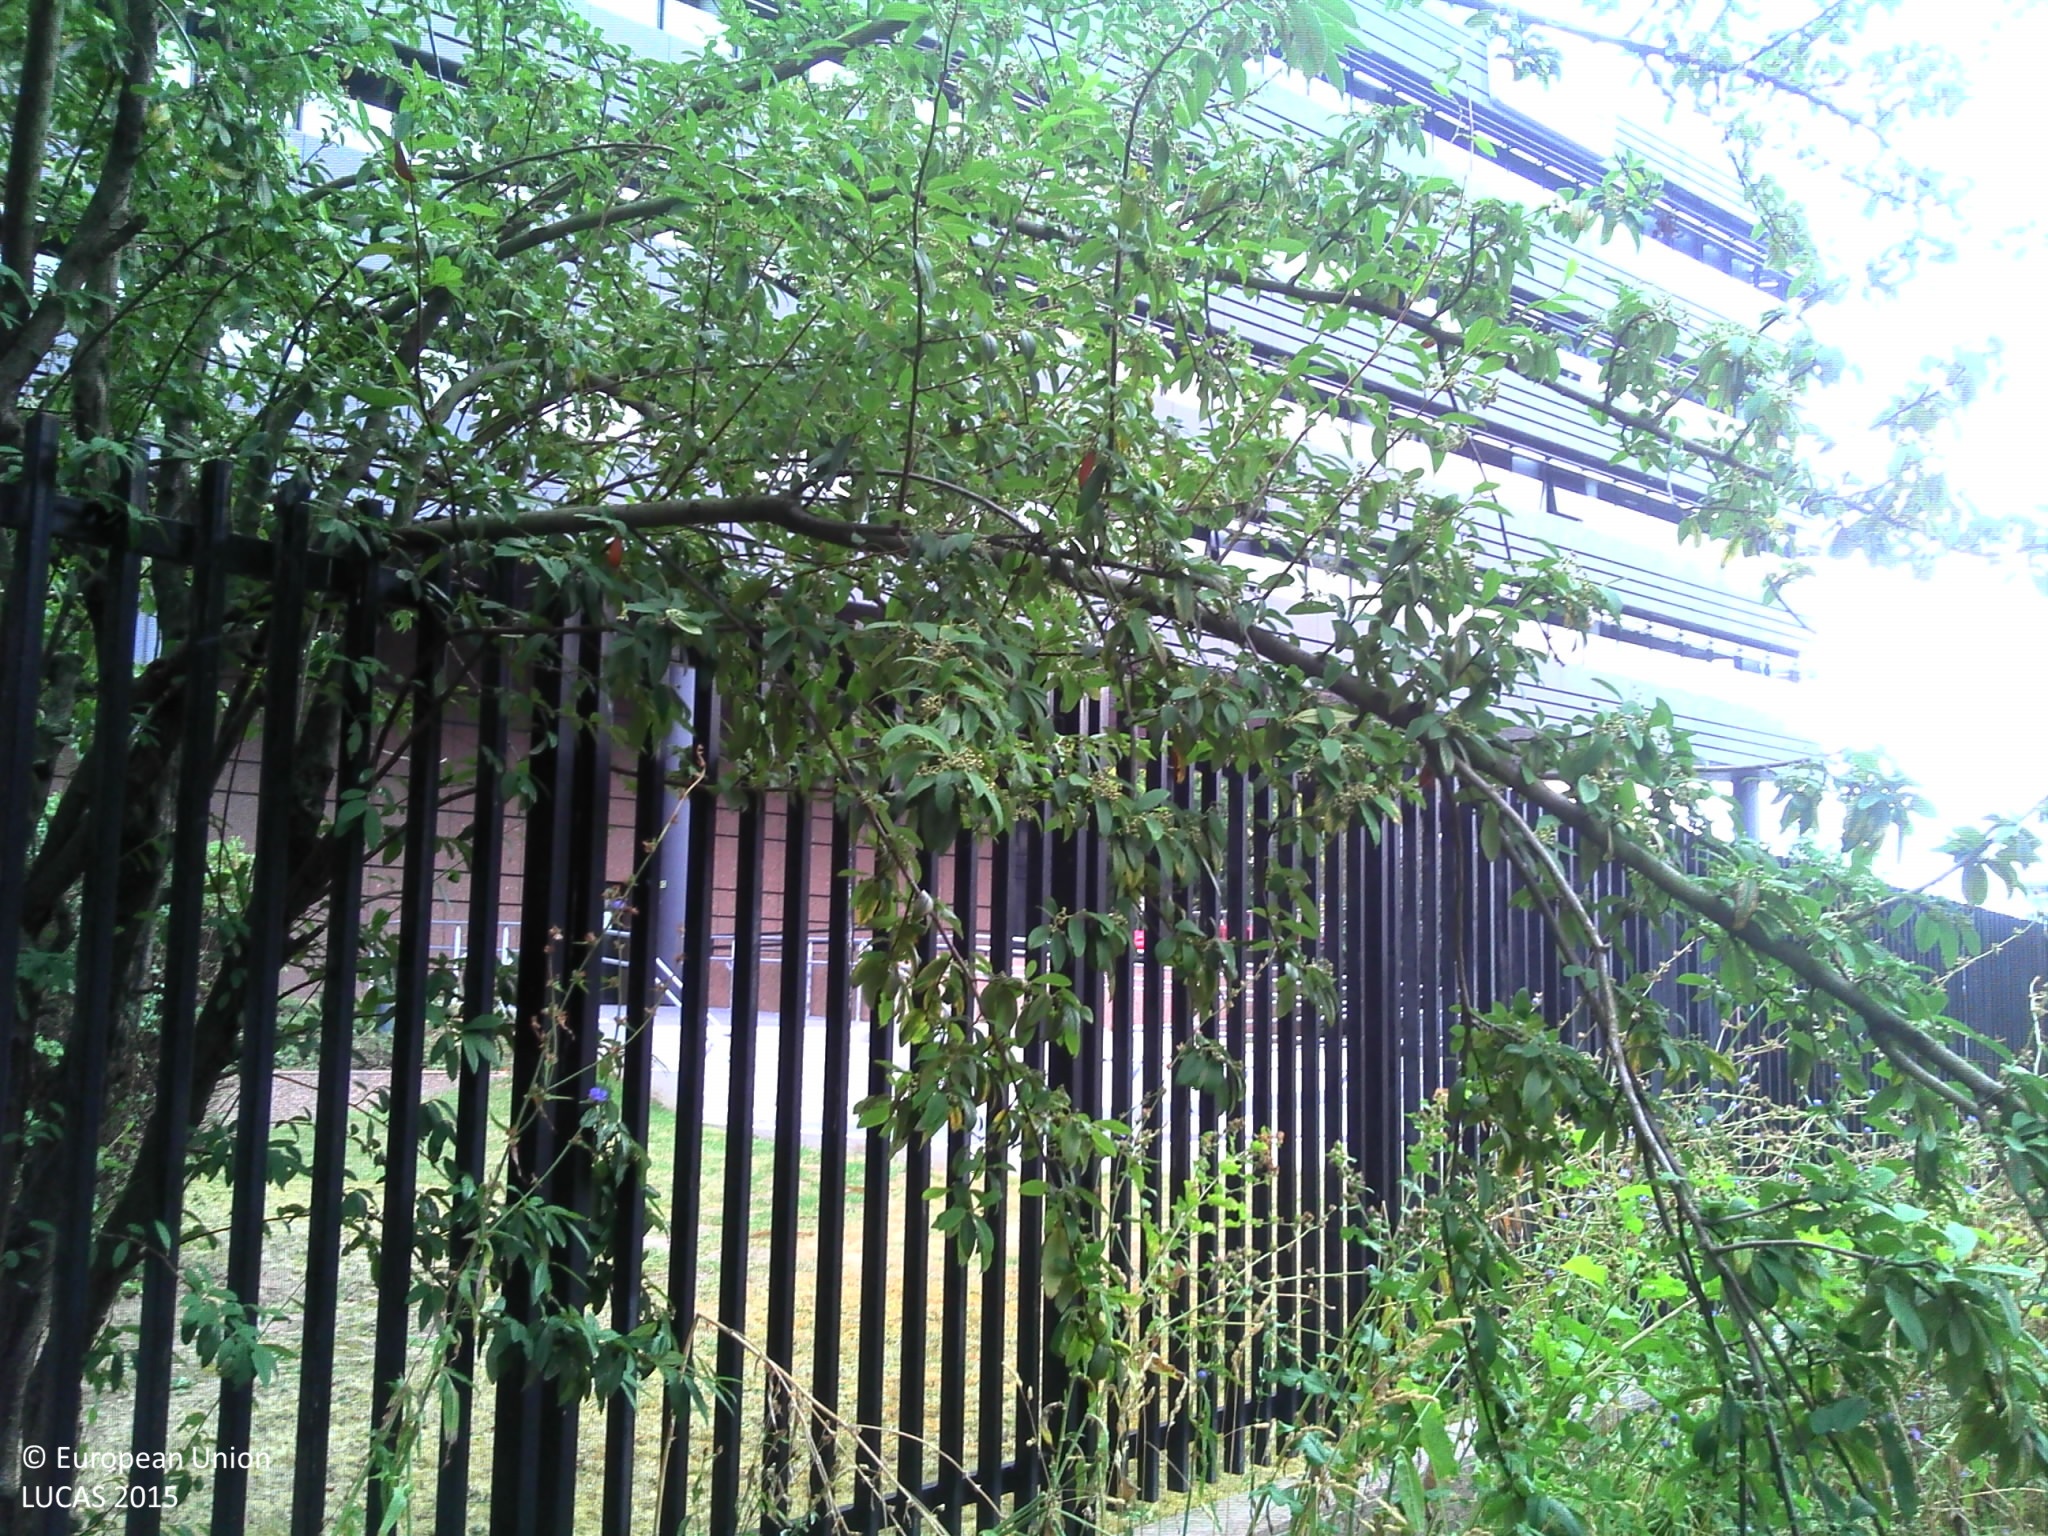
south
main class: Grassland
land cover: Spontaneously vegetated surfaces
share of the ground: > 75 %
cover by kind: herbaceous plants 100 %
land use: Community services
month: August
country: FR
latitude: 48.5784
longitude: 7.7372
